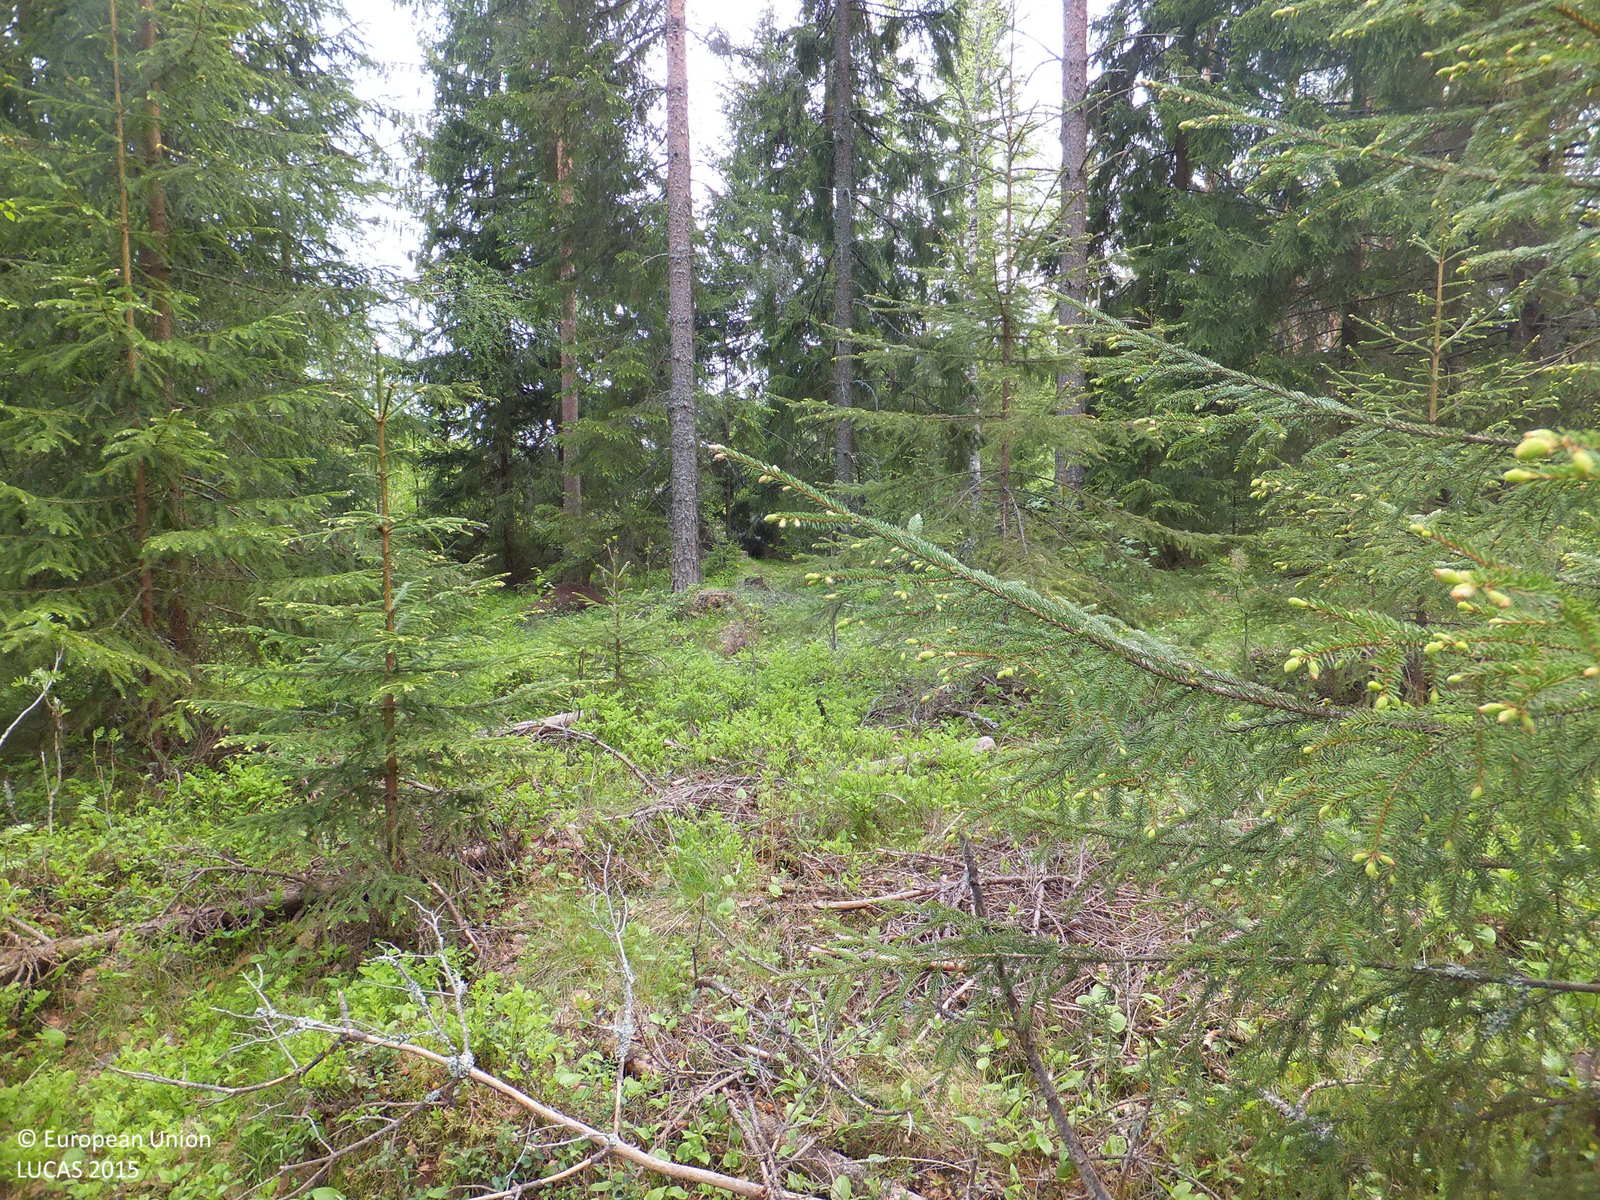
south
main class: Woodland
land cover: Pine dominated mixed woodland
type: boreal forest
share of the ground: 50 - 75 %
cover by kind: herbaceous plants 45 %, coniferous forest trees 30 %, broadleaved forest trees 20 %, shrubs 5 %
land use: Forestry
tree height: > 5 m
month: June
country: FI
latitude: 63.4324
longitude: 22.8587
